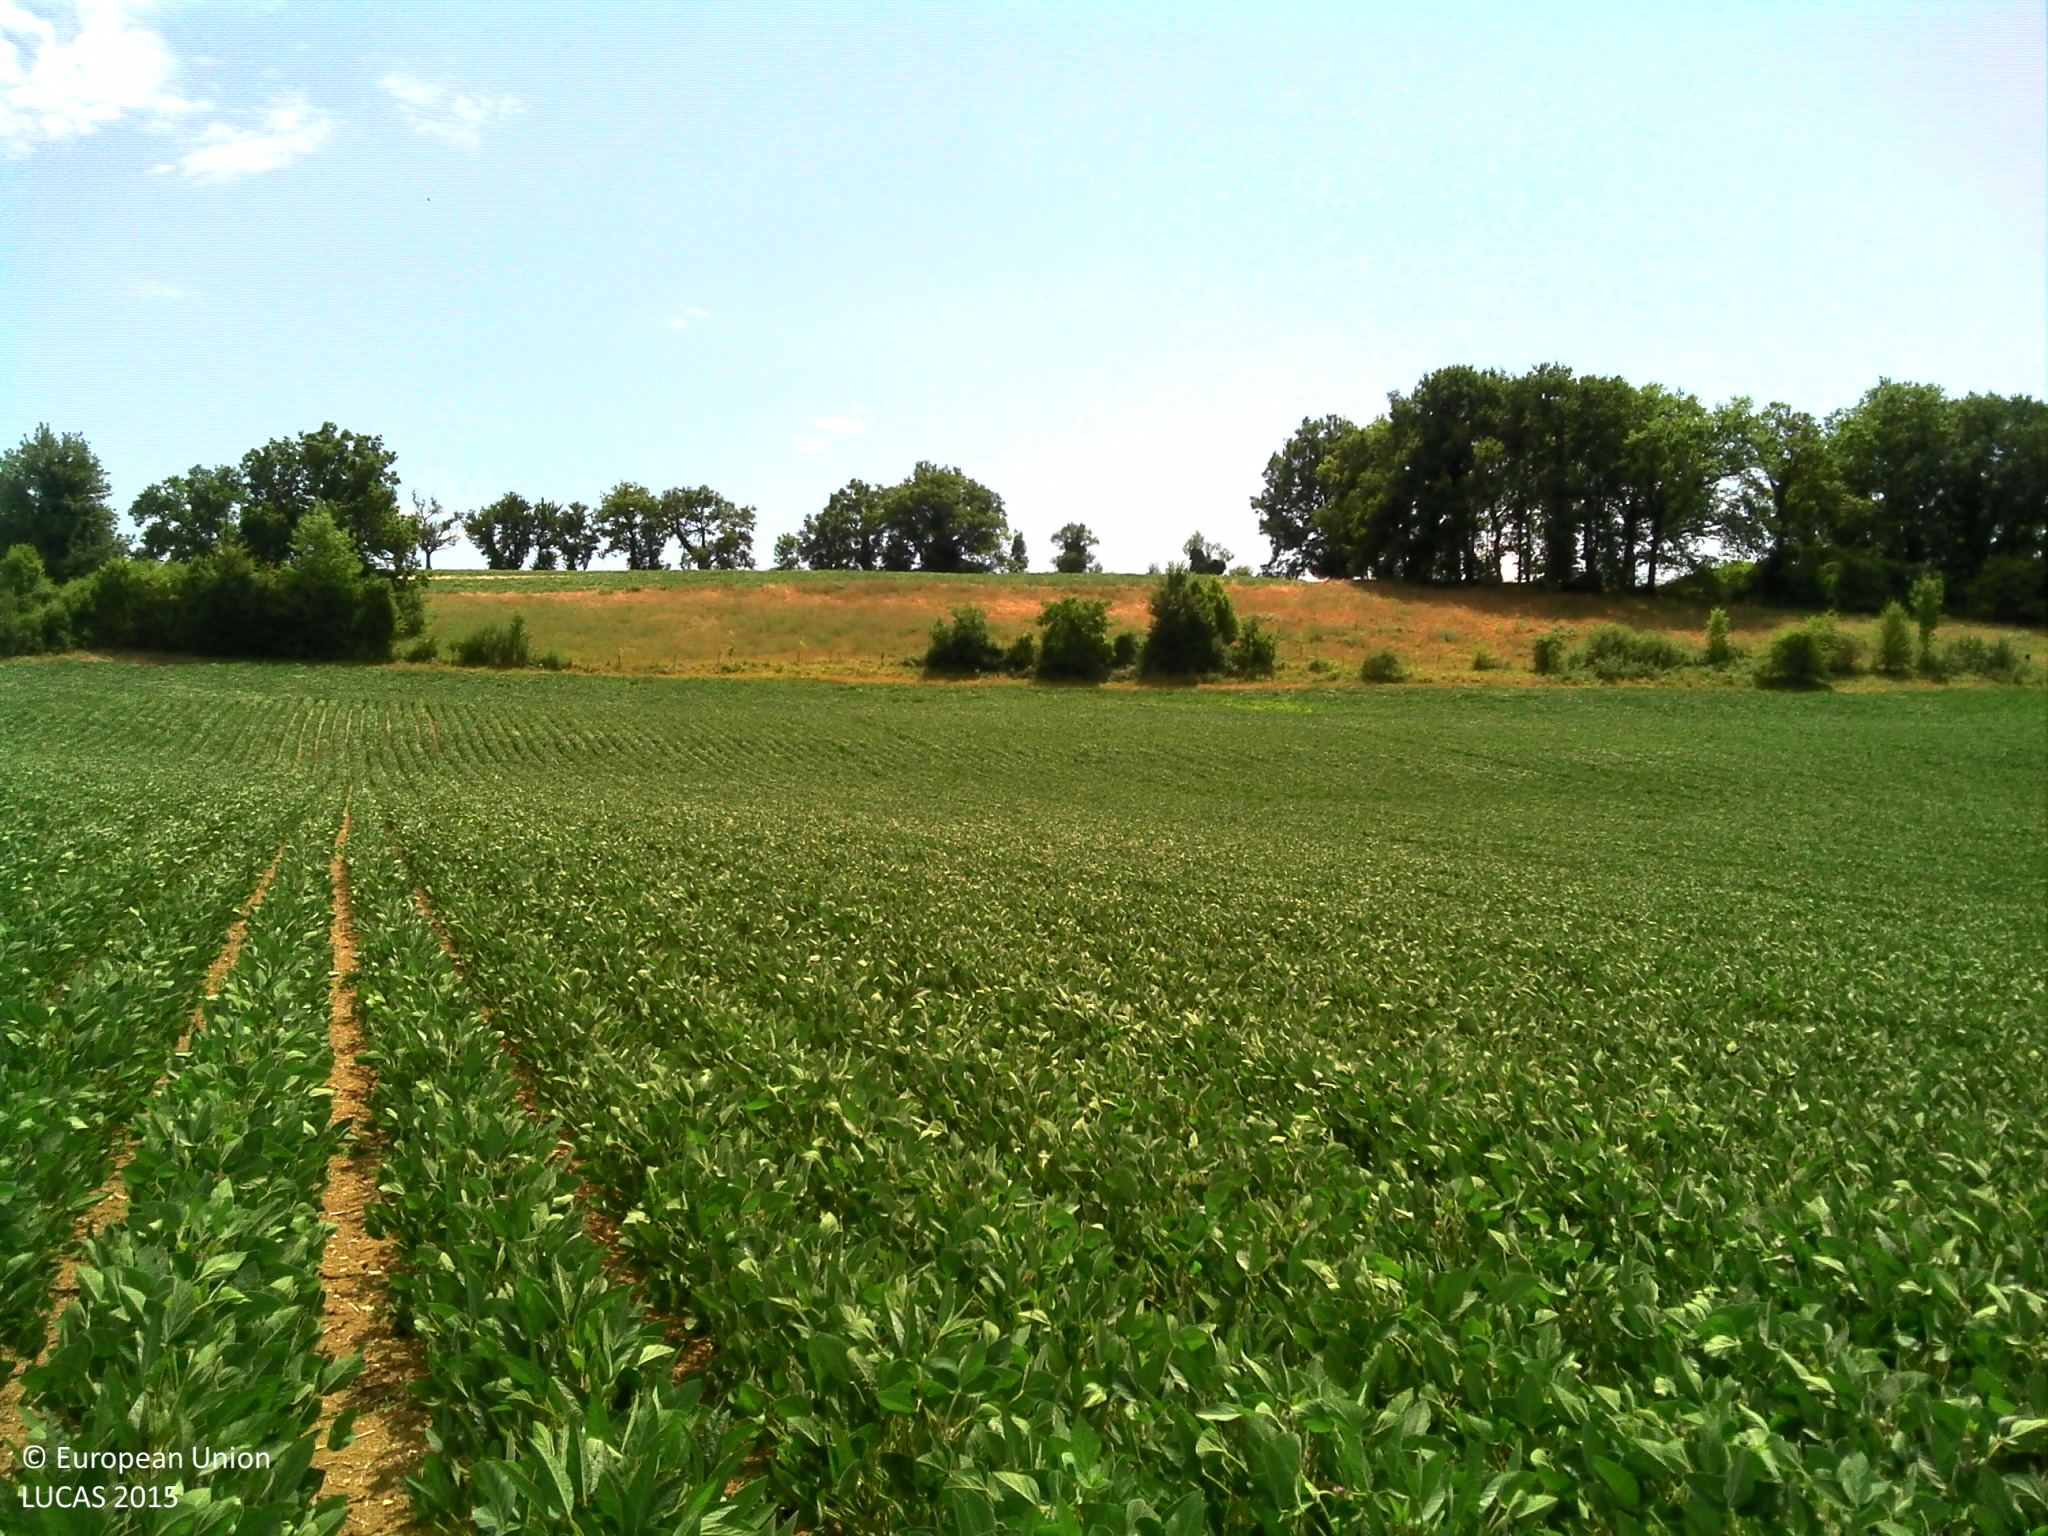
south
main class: Cropland
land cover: Soya
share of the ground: > 75 %
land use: Agriculture (excluding fallow land and kitchen gardens)
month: July
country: FR
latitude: 44.6442
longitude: 0.5483
